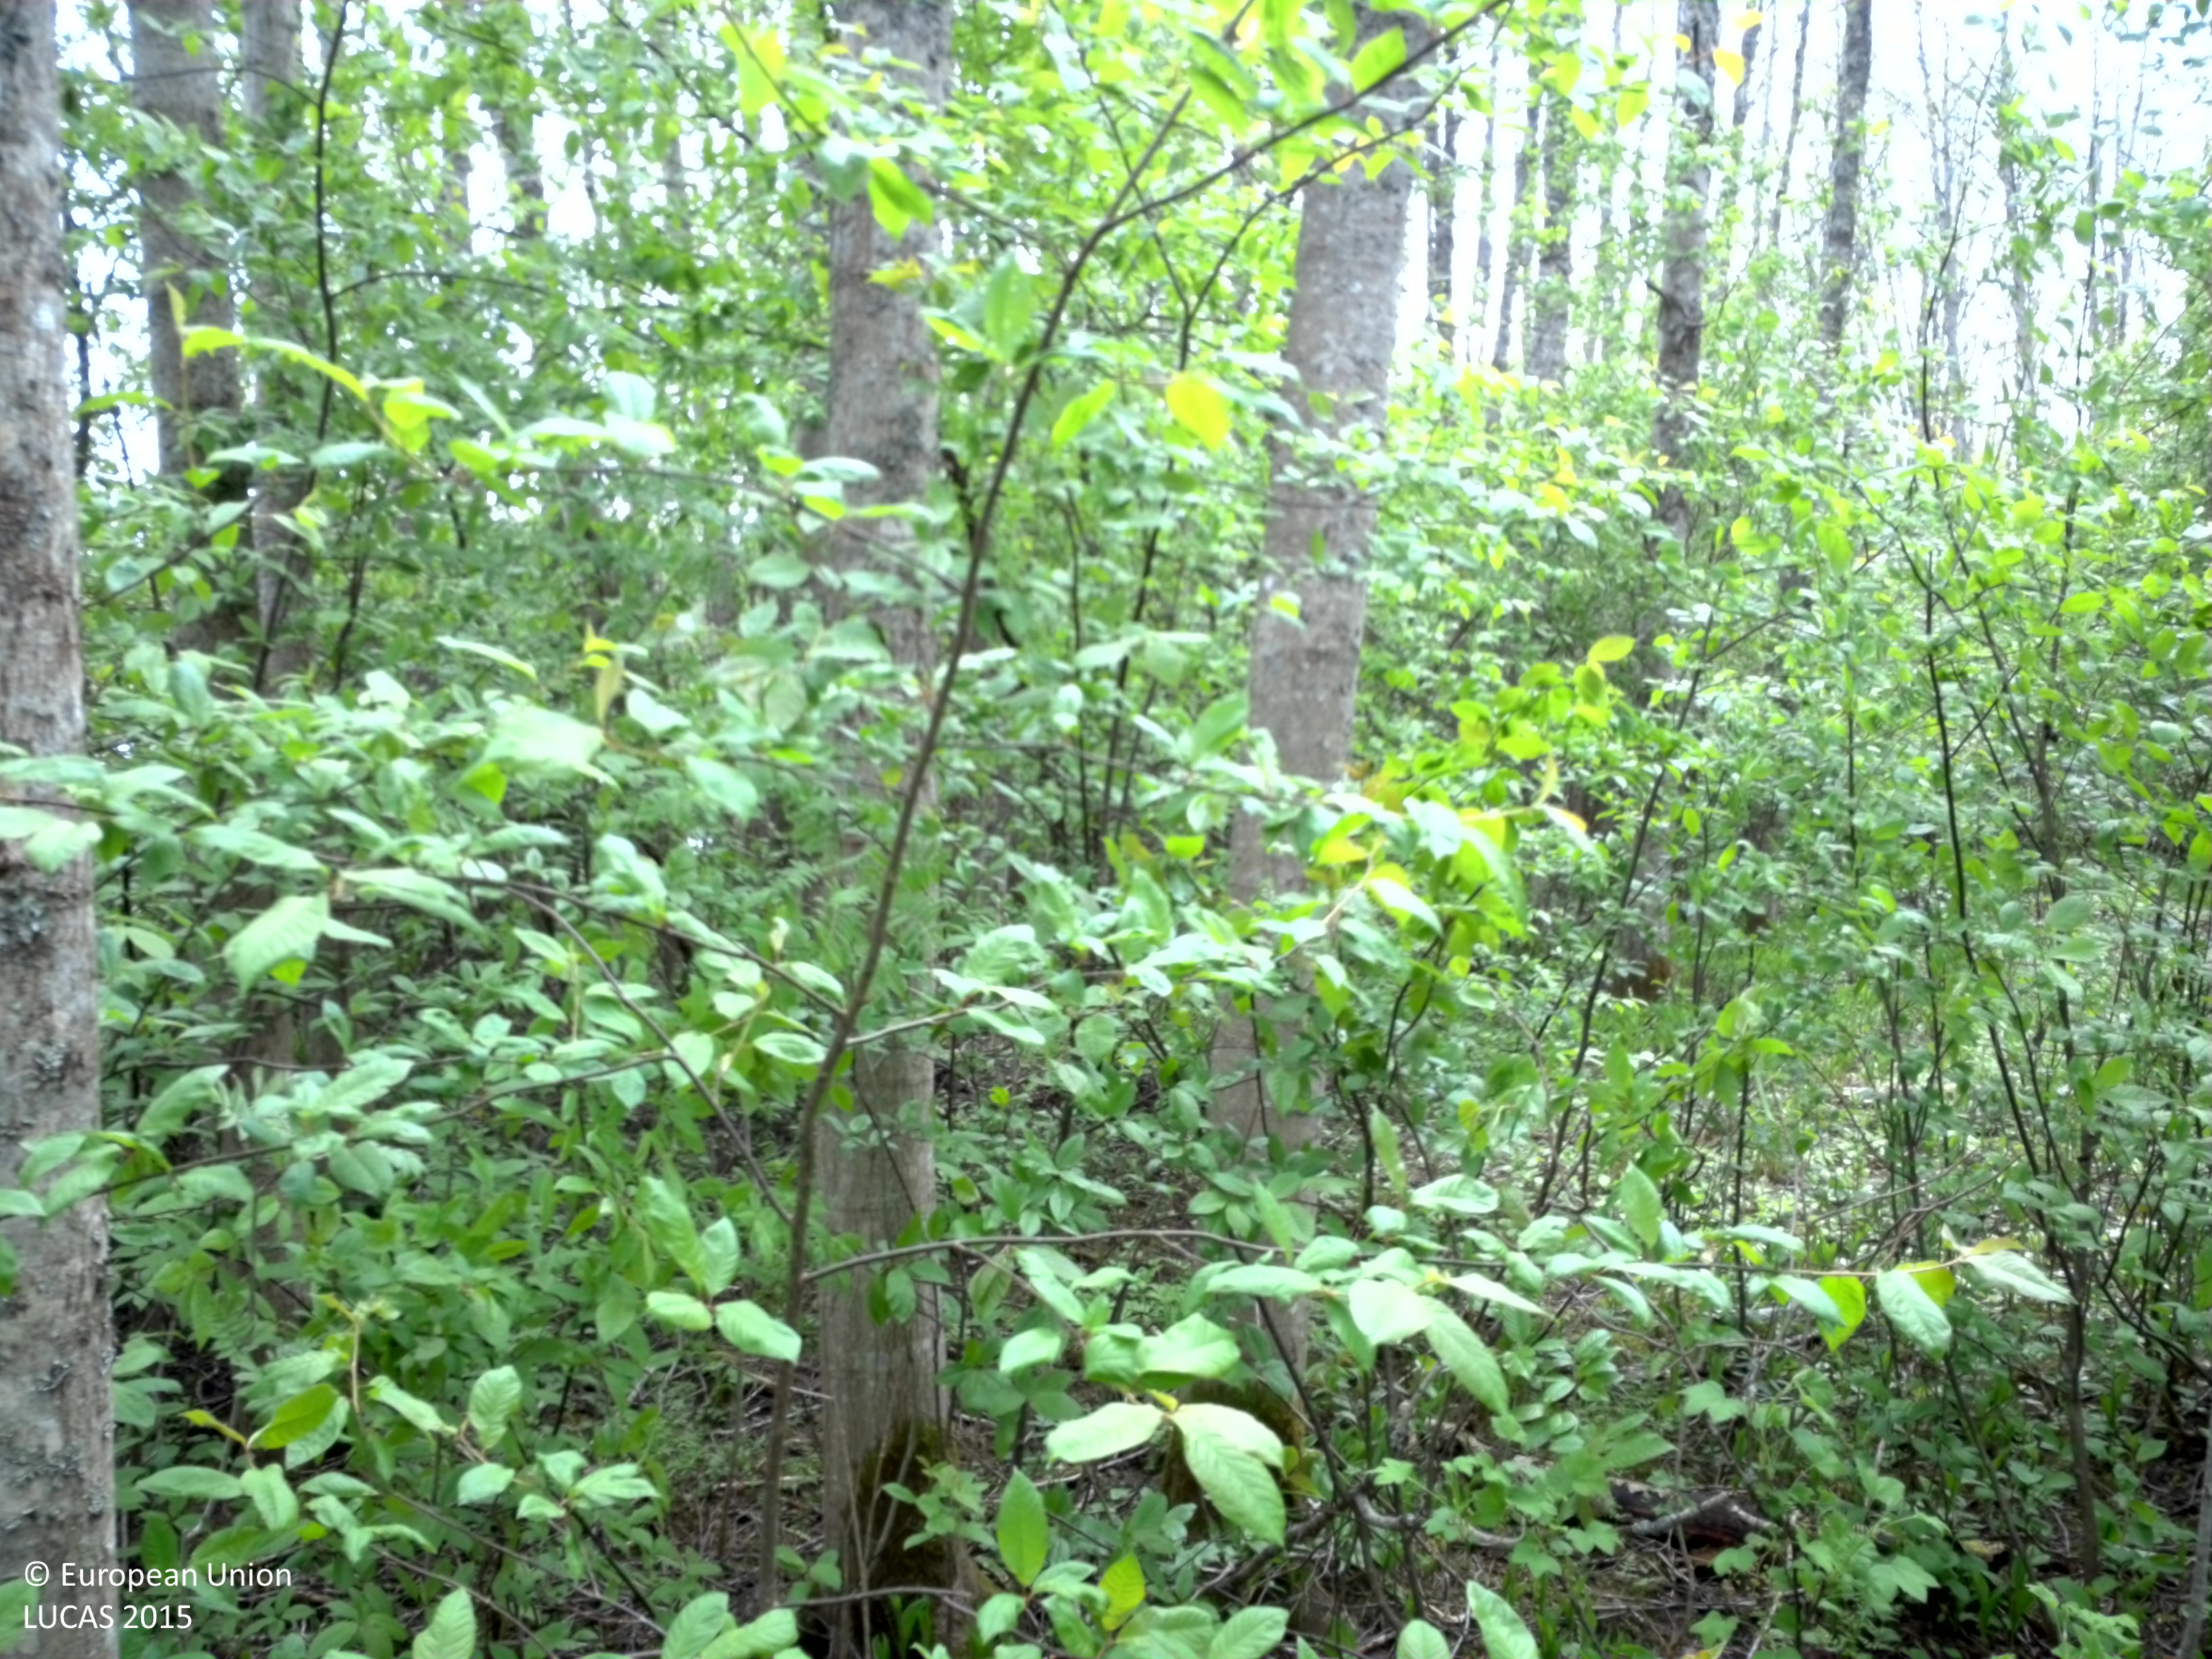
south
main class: Woodland
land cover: Broadleaved woodland
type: hemiboreal forest and nemoral coniferous forest and mixed broadleaved-coniferous forest
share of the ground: > 75 %
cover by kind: broadleaved forest trees 80 %, herbaceous plants 20 %
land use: Forestry
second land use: Amenities, museums, leisure
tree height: > 5 m
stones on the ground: < 10 %
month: May
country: SE
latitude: 60.2836
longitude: 13.4085
